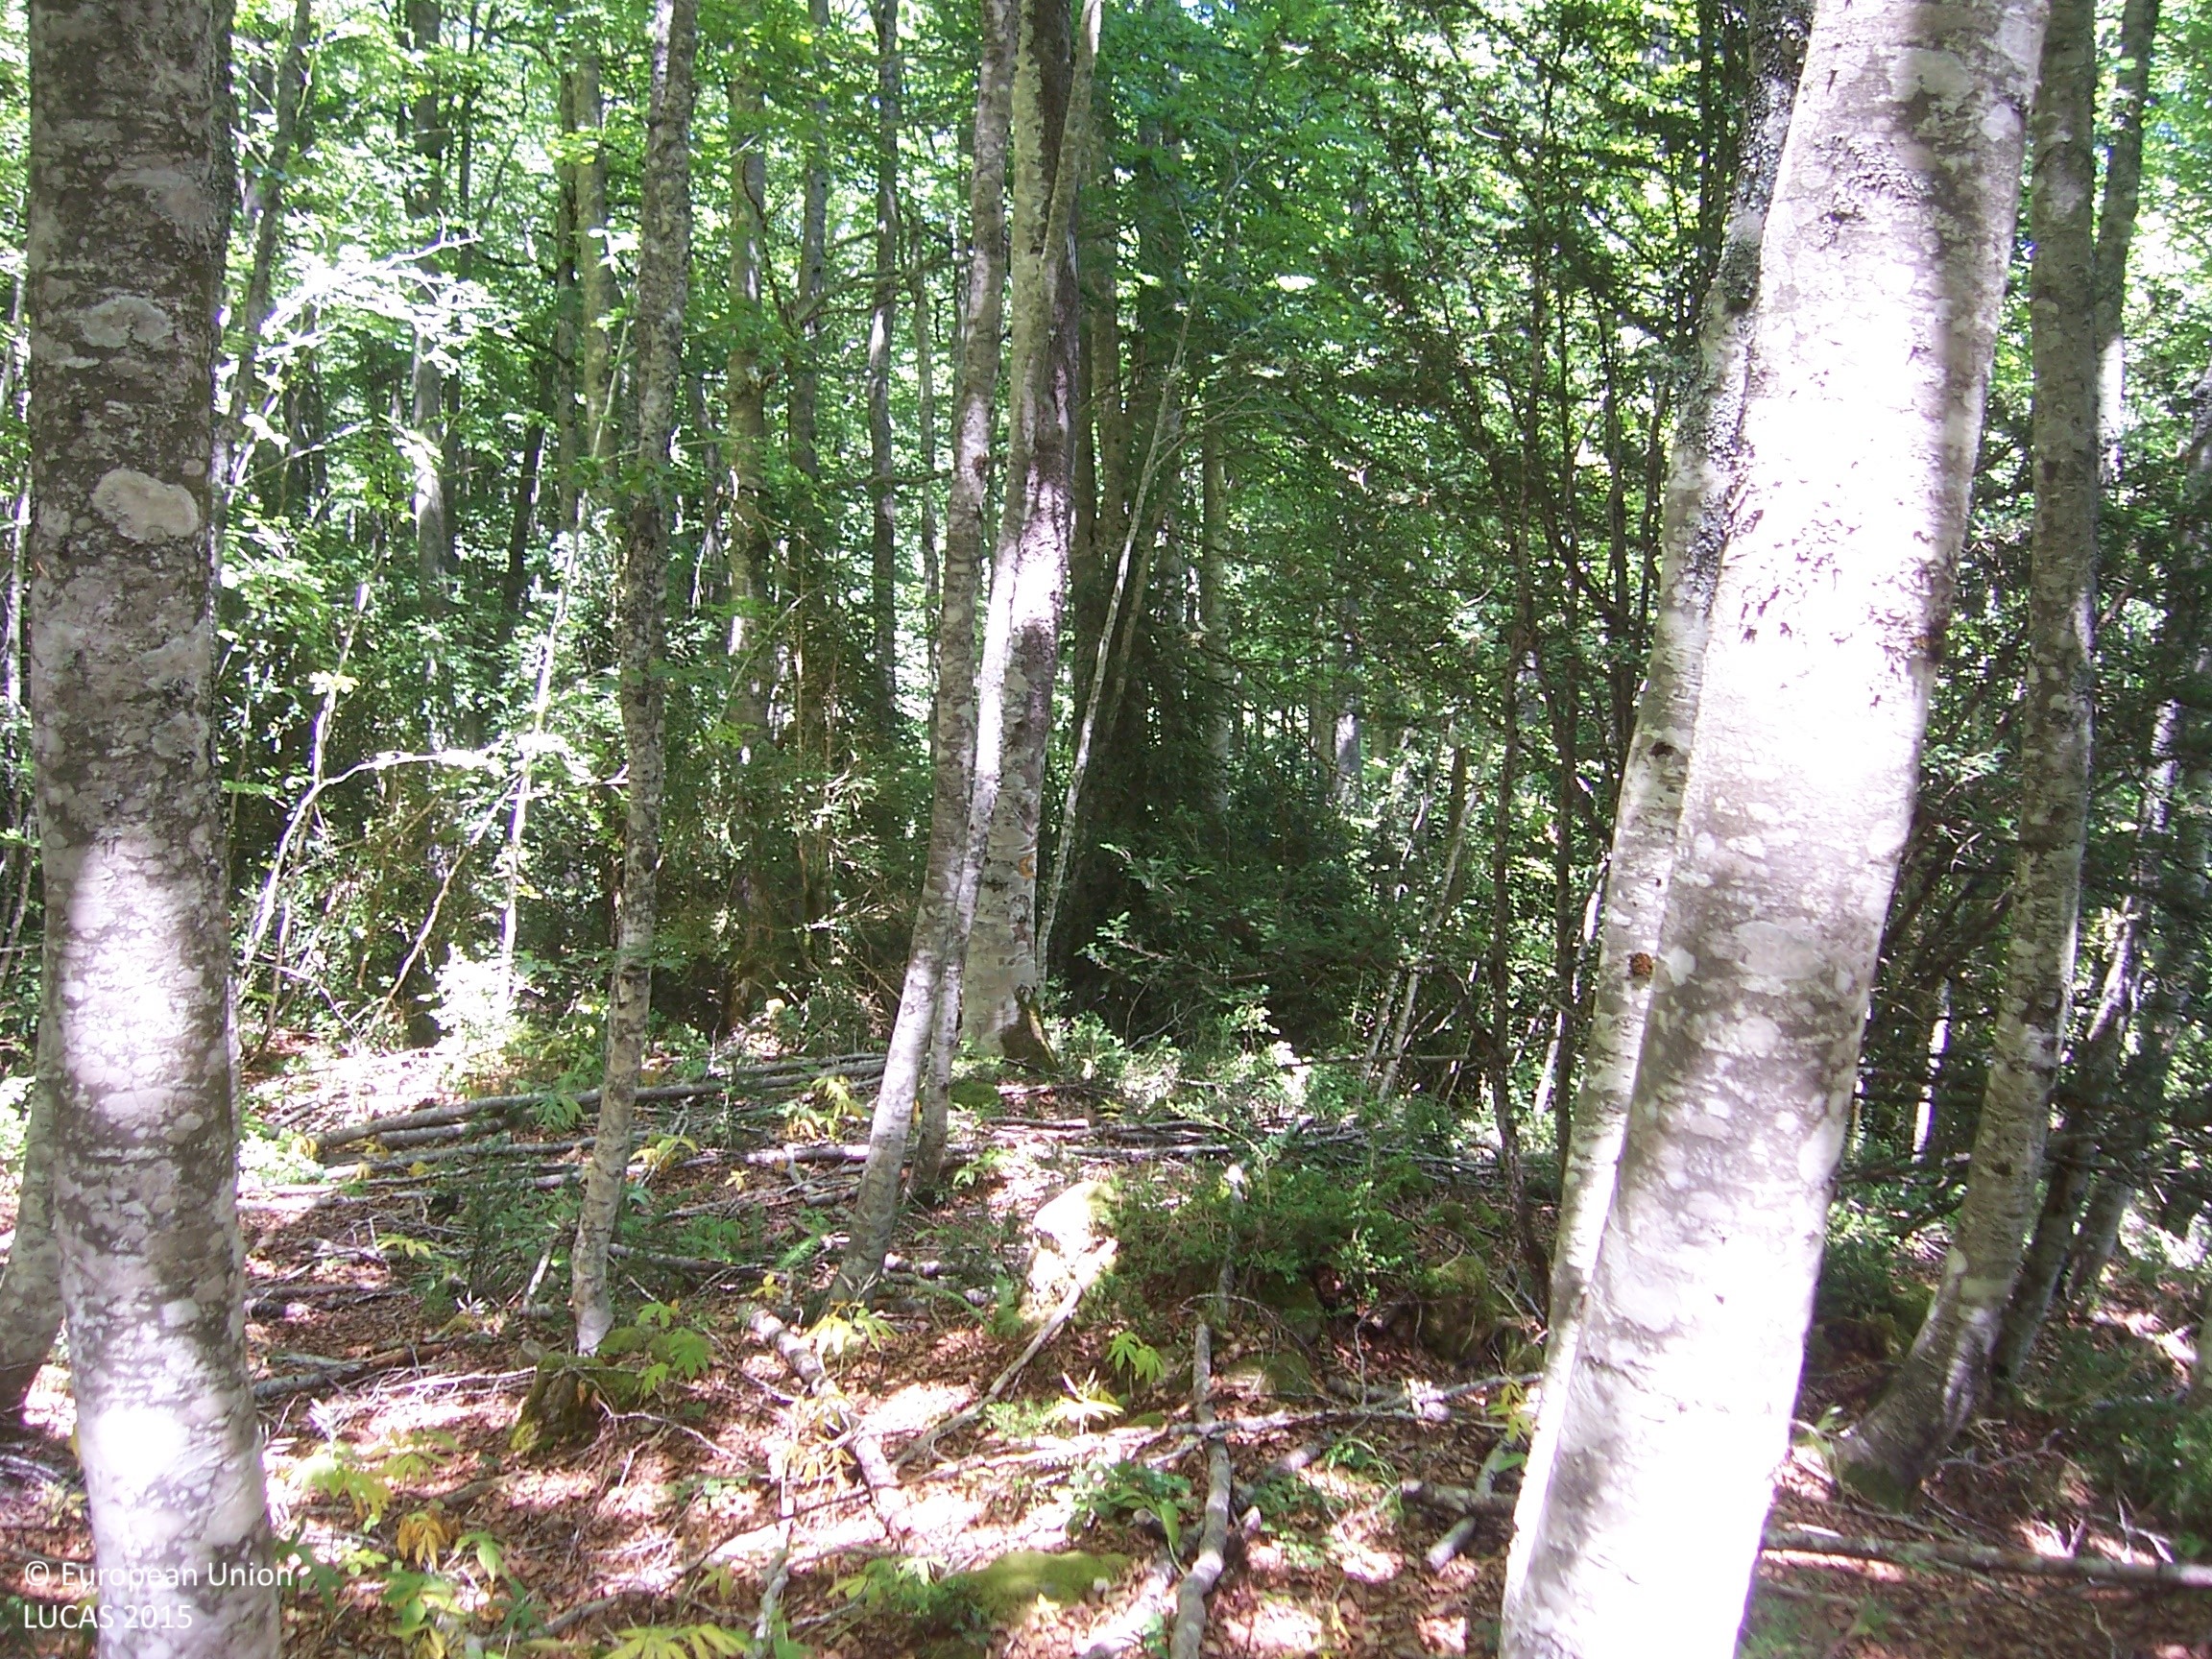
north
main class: Woodland
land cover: Broadleaved woodland
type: beech forest
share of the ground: > 75 %
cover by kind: broadleaved forest trees 100 %
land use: Forestry
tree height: > 5 m
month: July
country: ES
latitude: 42.8522
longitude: -1.1832
